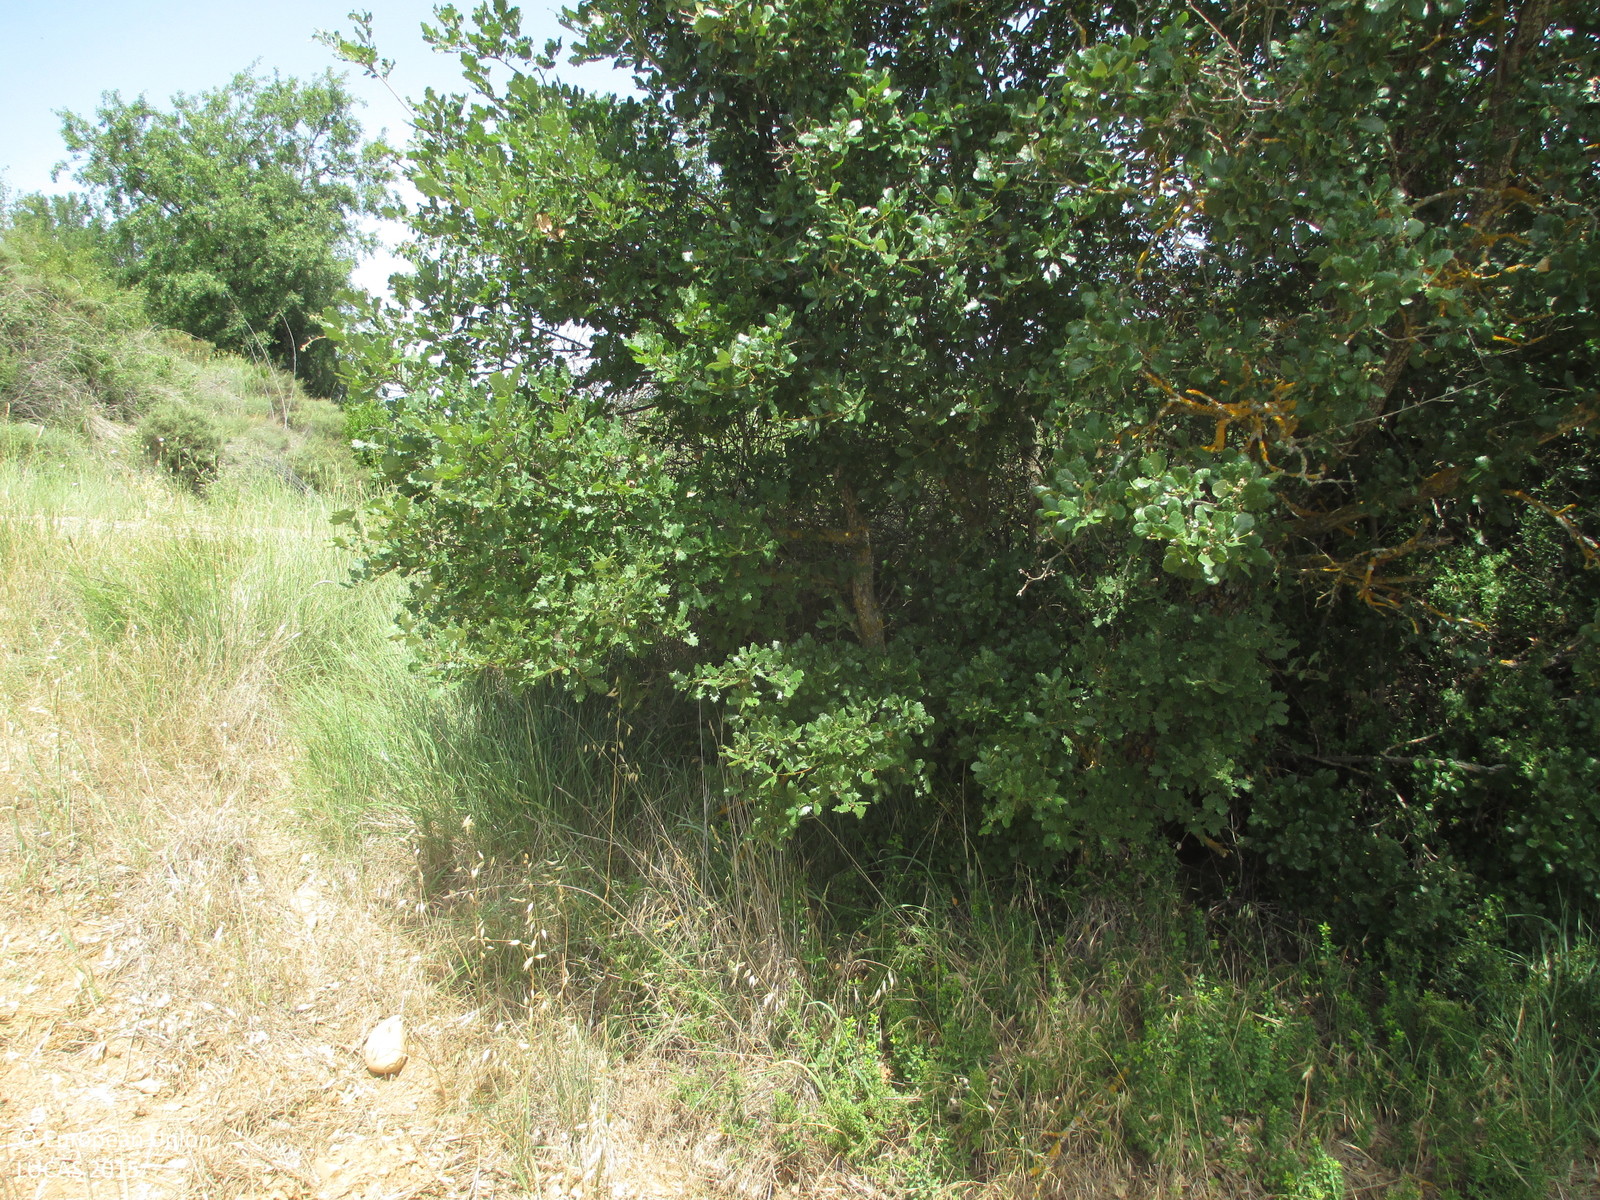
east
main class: Cropland
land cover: Common wheat
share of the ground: > 75 %
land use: Agriculture (excluding fallow land and kitchen gardens)
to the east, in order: Common wheat; Single bushes/trees; Tracks; Dry stone walls; Railways; Other bare soil; Shrubland with sparse tree cover; Electric lines; Shrubland with sparse tree cover; Broadleaved woodland; Barley; Broadleaved woodland
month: July
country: ES
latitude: 42.4198
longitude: -0.4647
